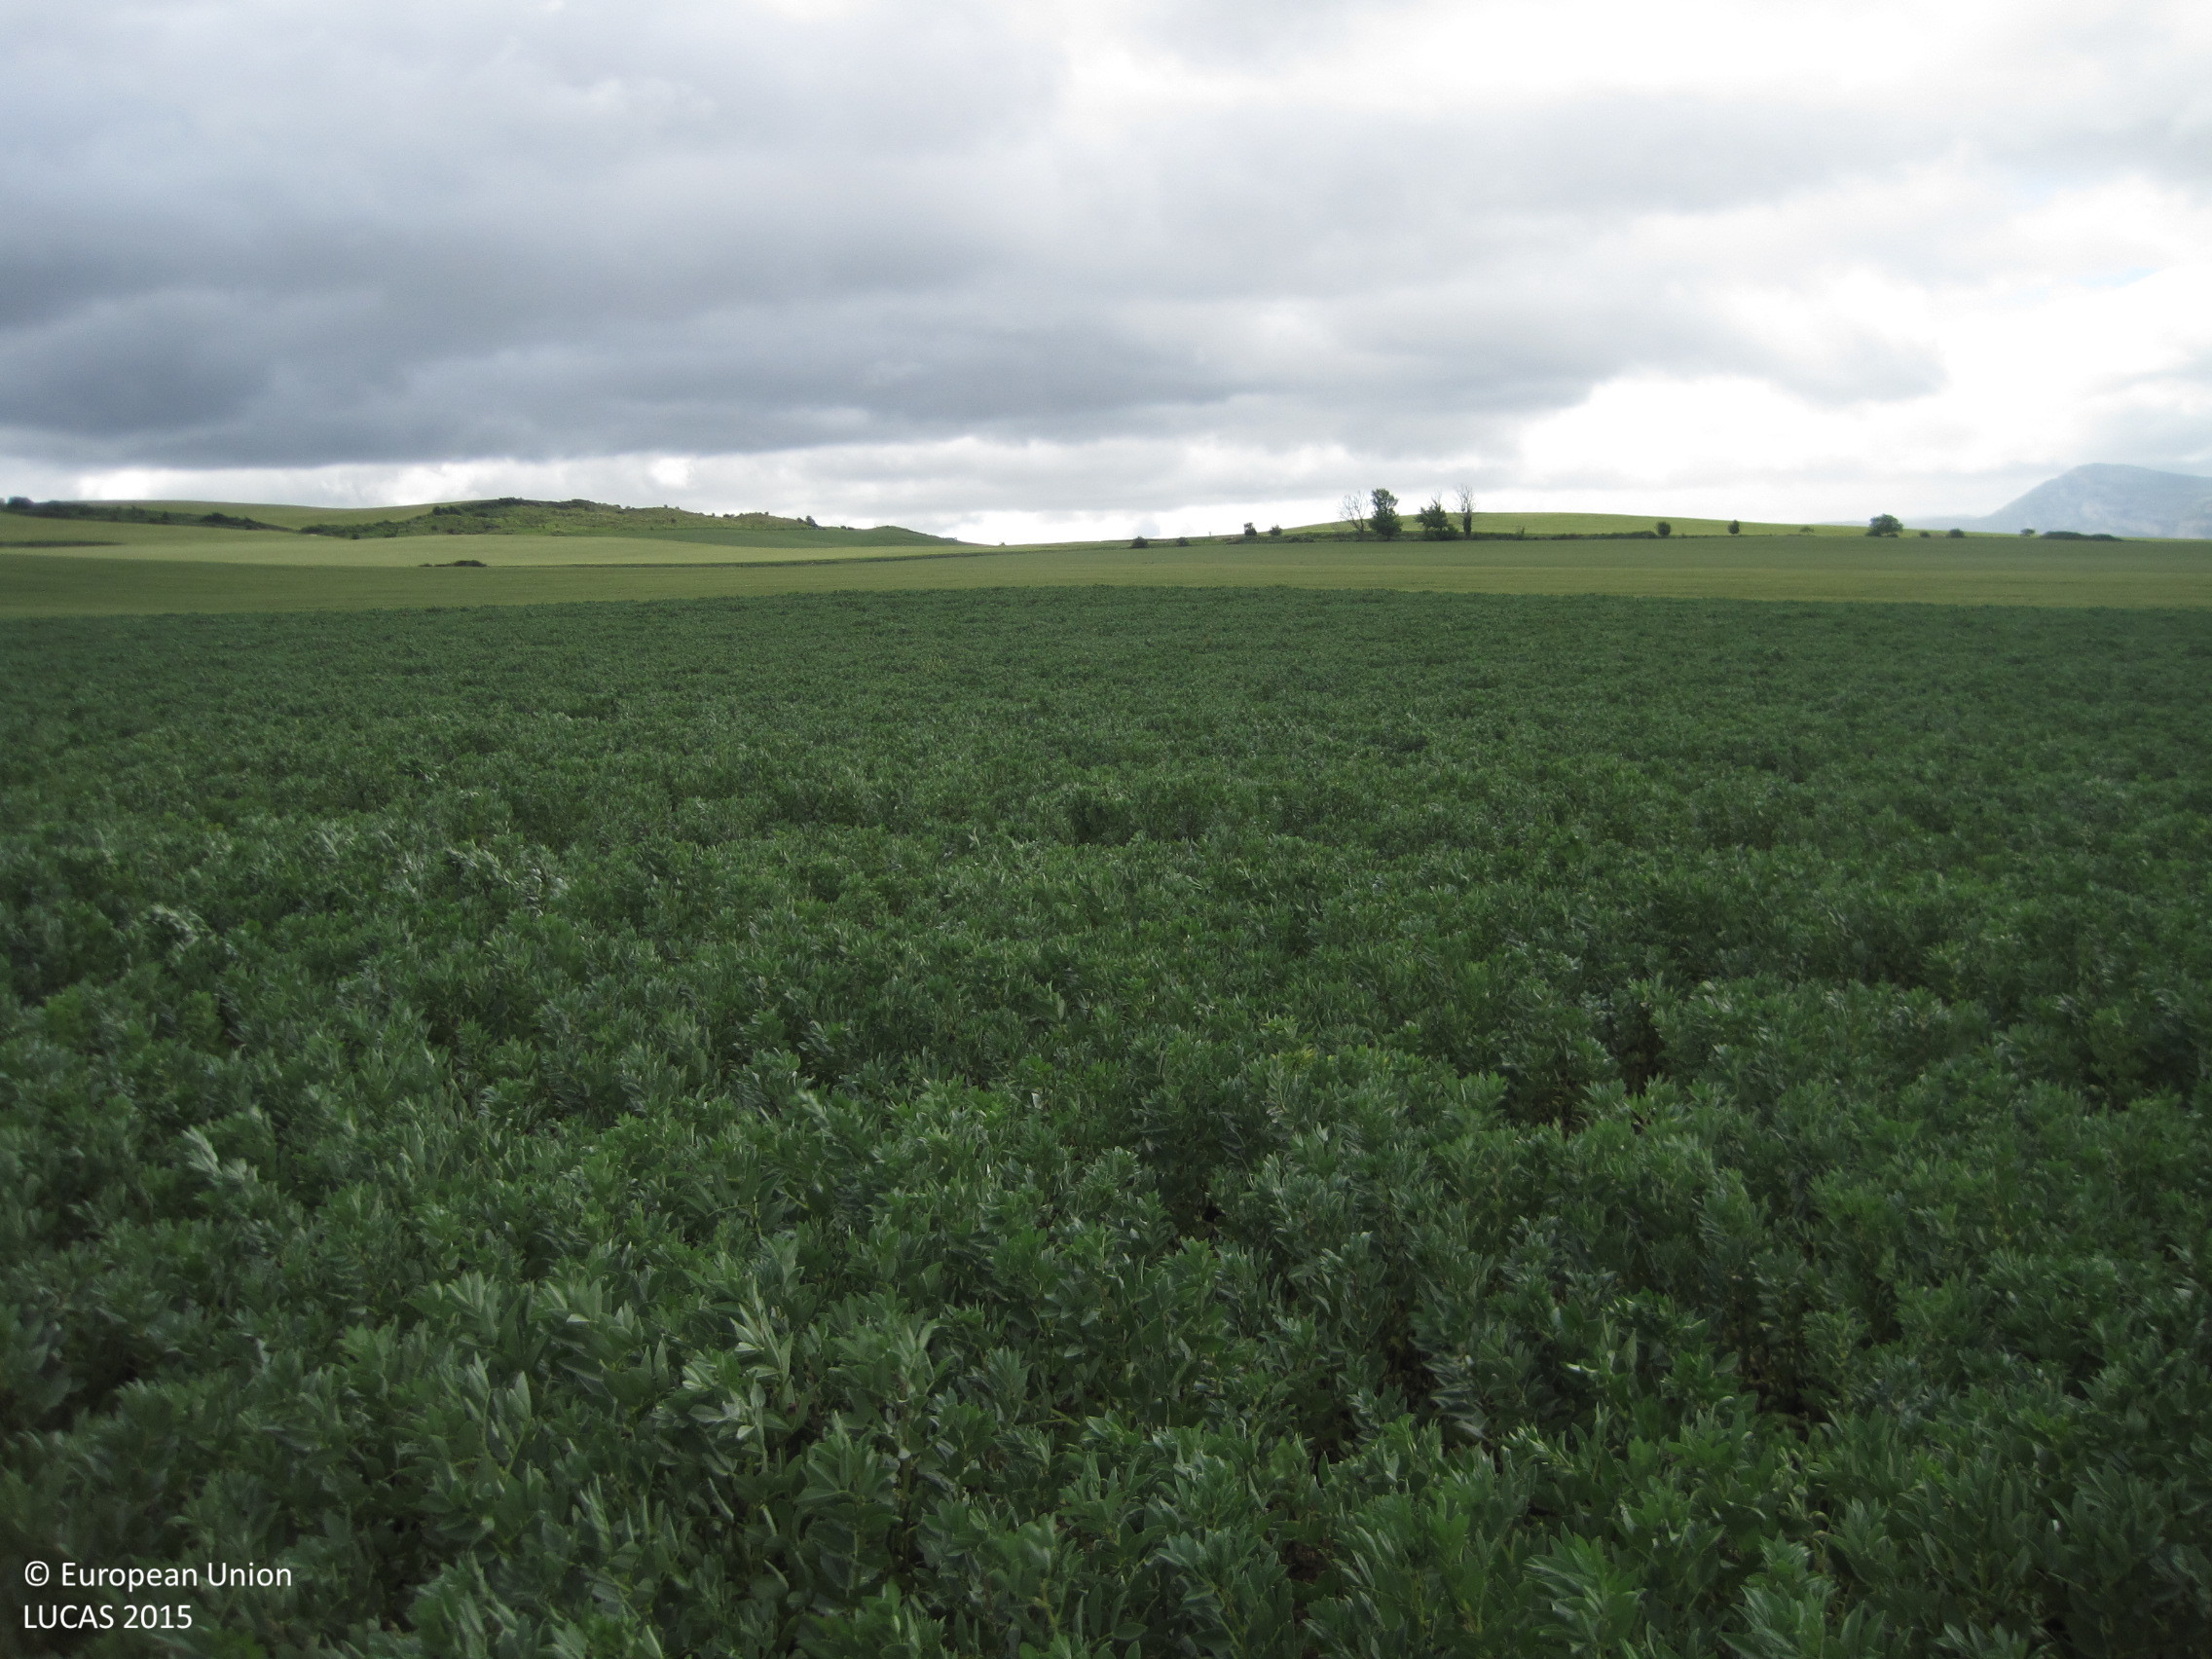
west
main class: Cropland
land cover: Dry pulses
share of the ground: > 75 %
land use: Agriculture (excluding fallow land and kitchen gardens)
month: May
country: ES
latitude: 42.7563
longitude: -1.7079
